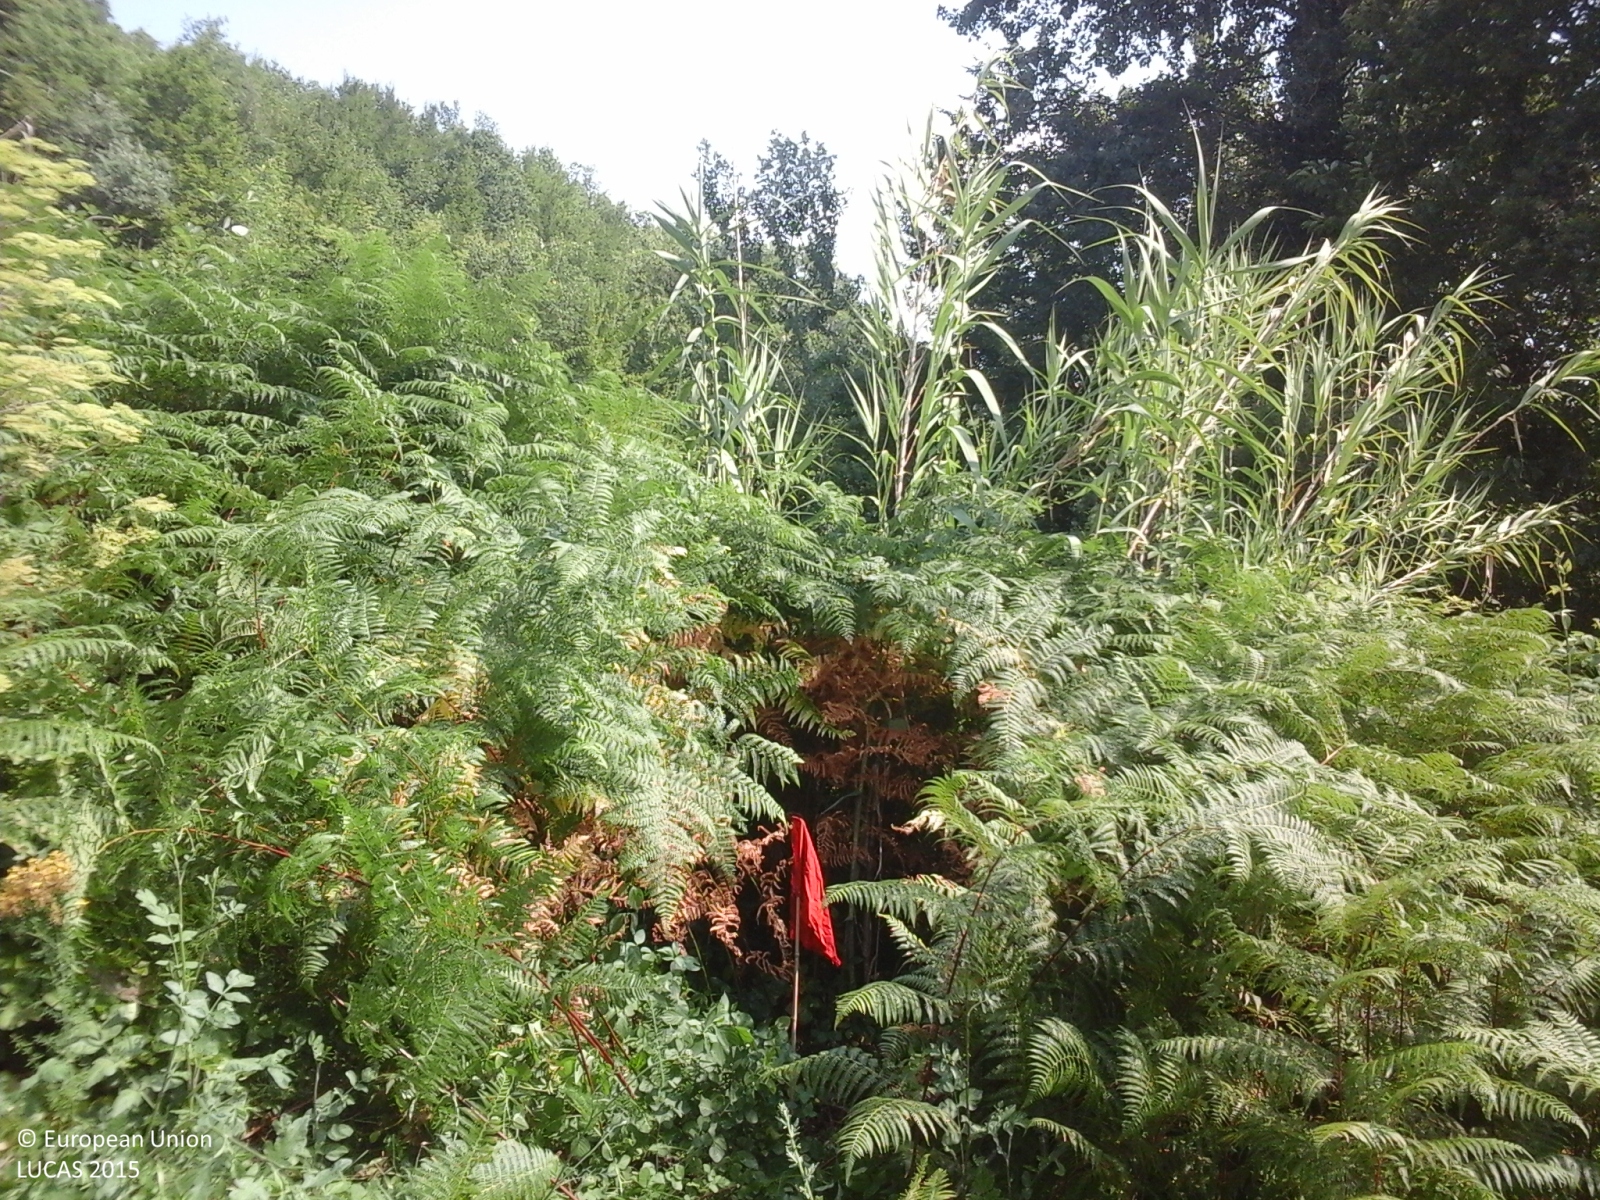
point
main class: Shrubland
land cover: Shrubland without tree cover
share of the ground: > 75 %
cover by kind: shrubs 100 %
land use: Semi-natural and natural areas not in use
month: July
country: IT
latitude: 42.9564
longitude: 13.4594
